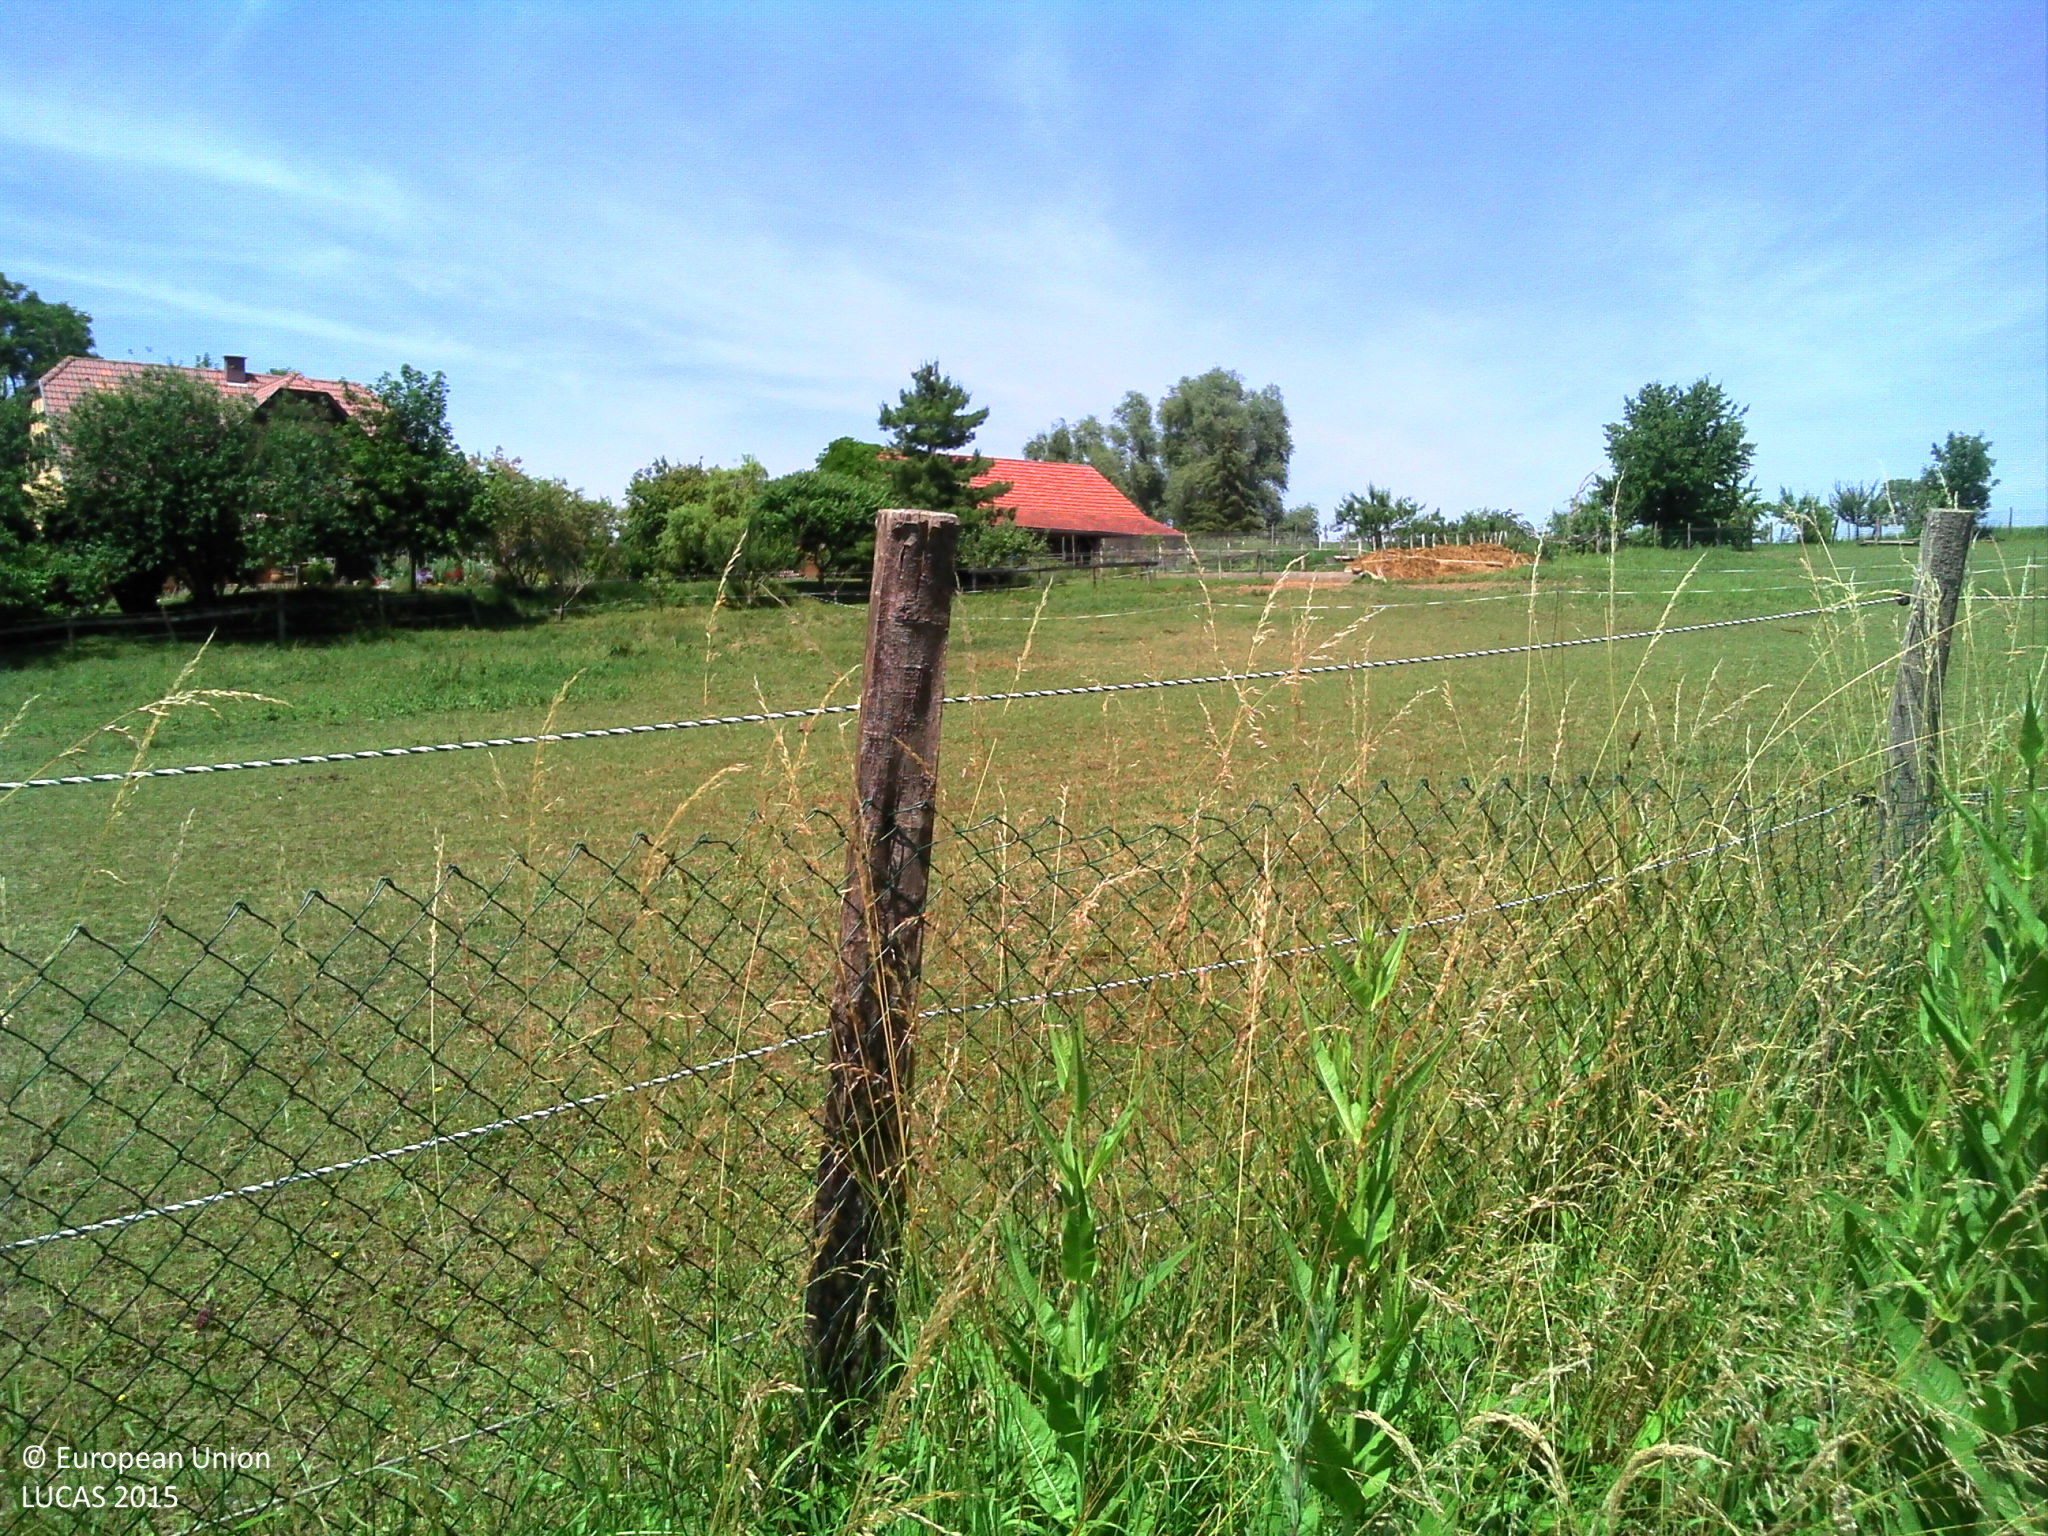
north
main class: Grassland
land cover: Grassland without tree/shrub cover
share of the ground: > 75 %
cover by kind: herbaceous plants 100 %
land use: Agriculture (excluding fallow land and kitchen gardens)
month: June
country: FR
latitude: 48.7193
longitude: 7.5949
